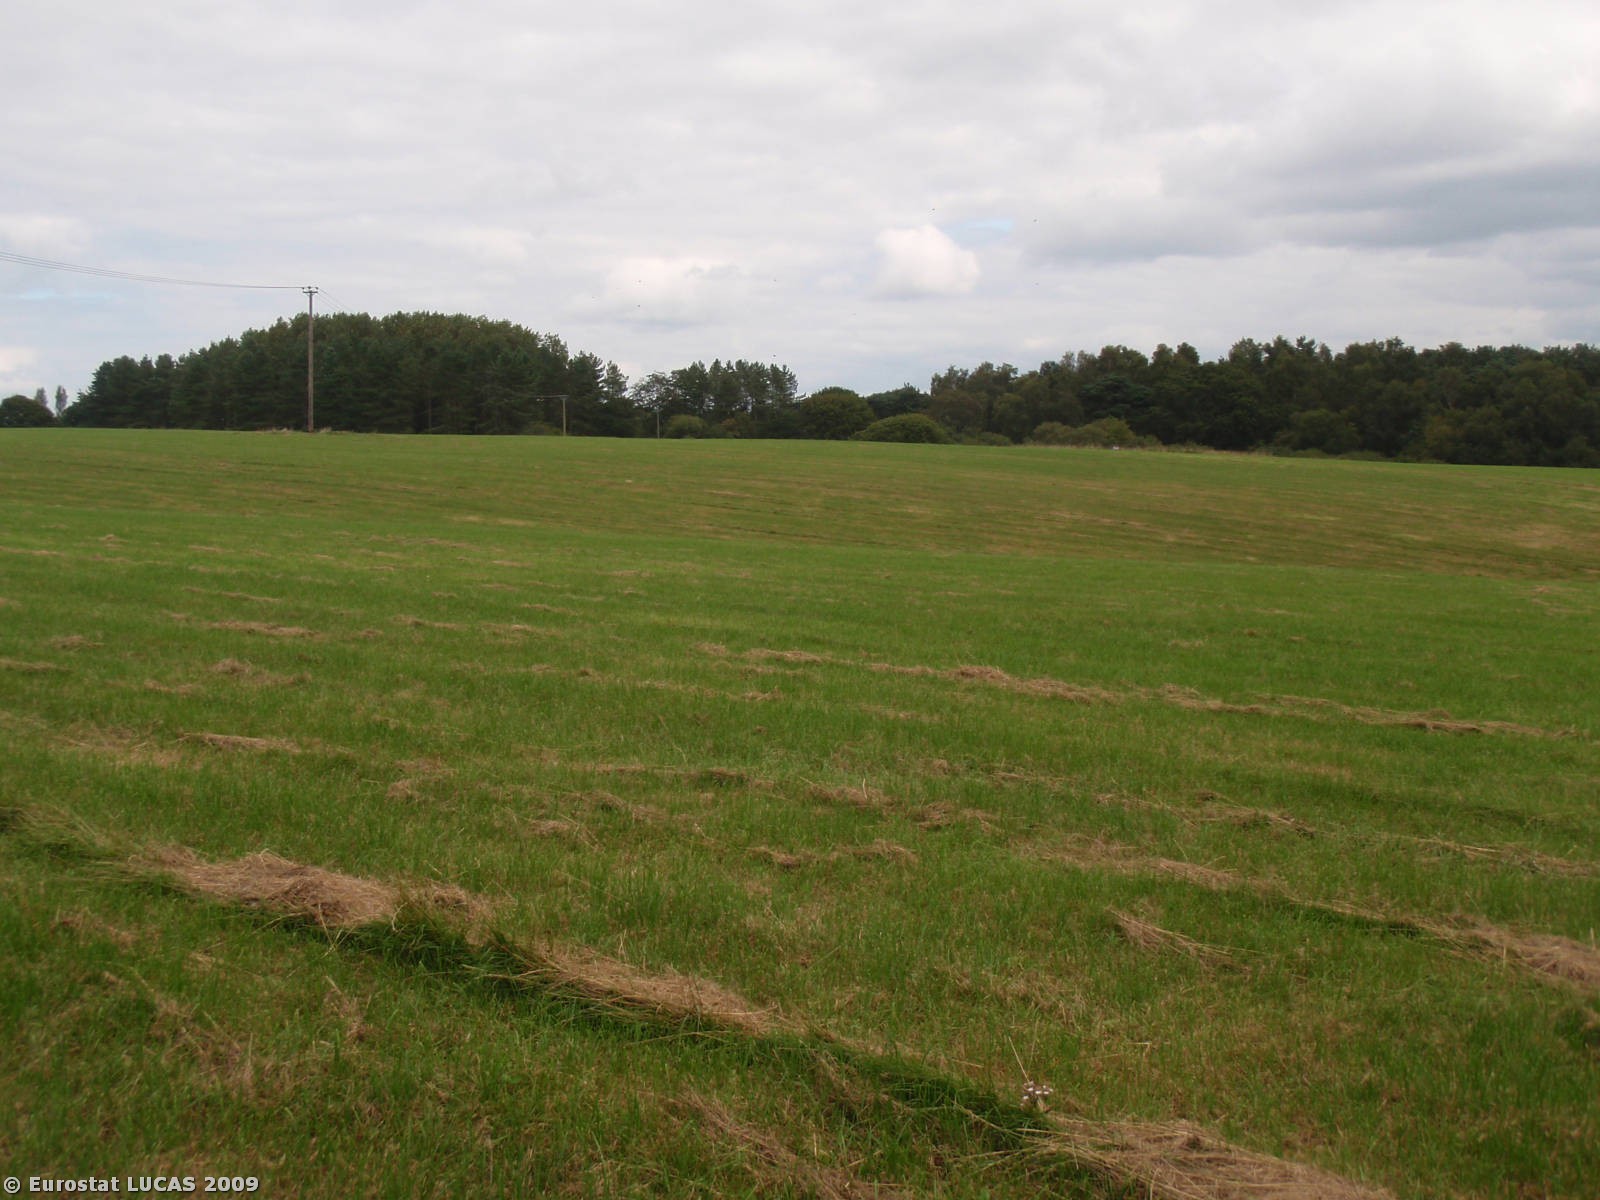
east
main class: Grassland
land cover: Grassland without tree/shrub cover
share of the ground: > 75 %
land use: Agriculture (excluding fallow land and kitchen gardens)
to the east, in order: Grassland without tree/shrub cover; Spontaneously vegetated surfaces; Fences; Mixed woodland
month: August
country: GB
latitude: 50.7590
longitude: -2.0664
